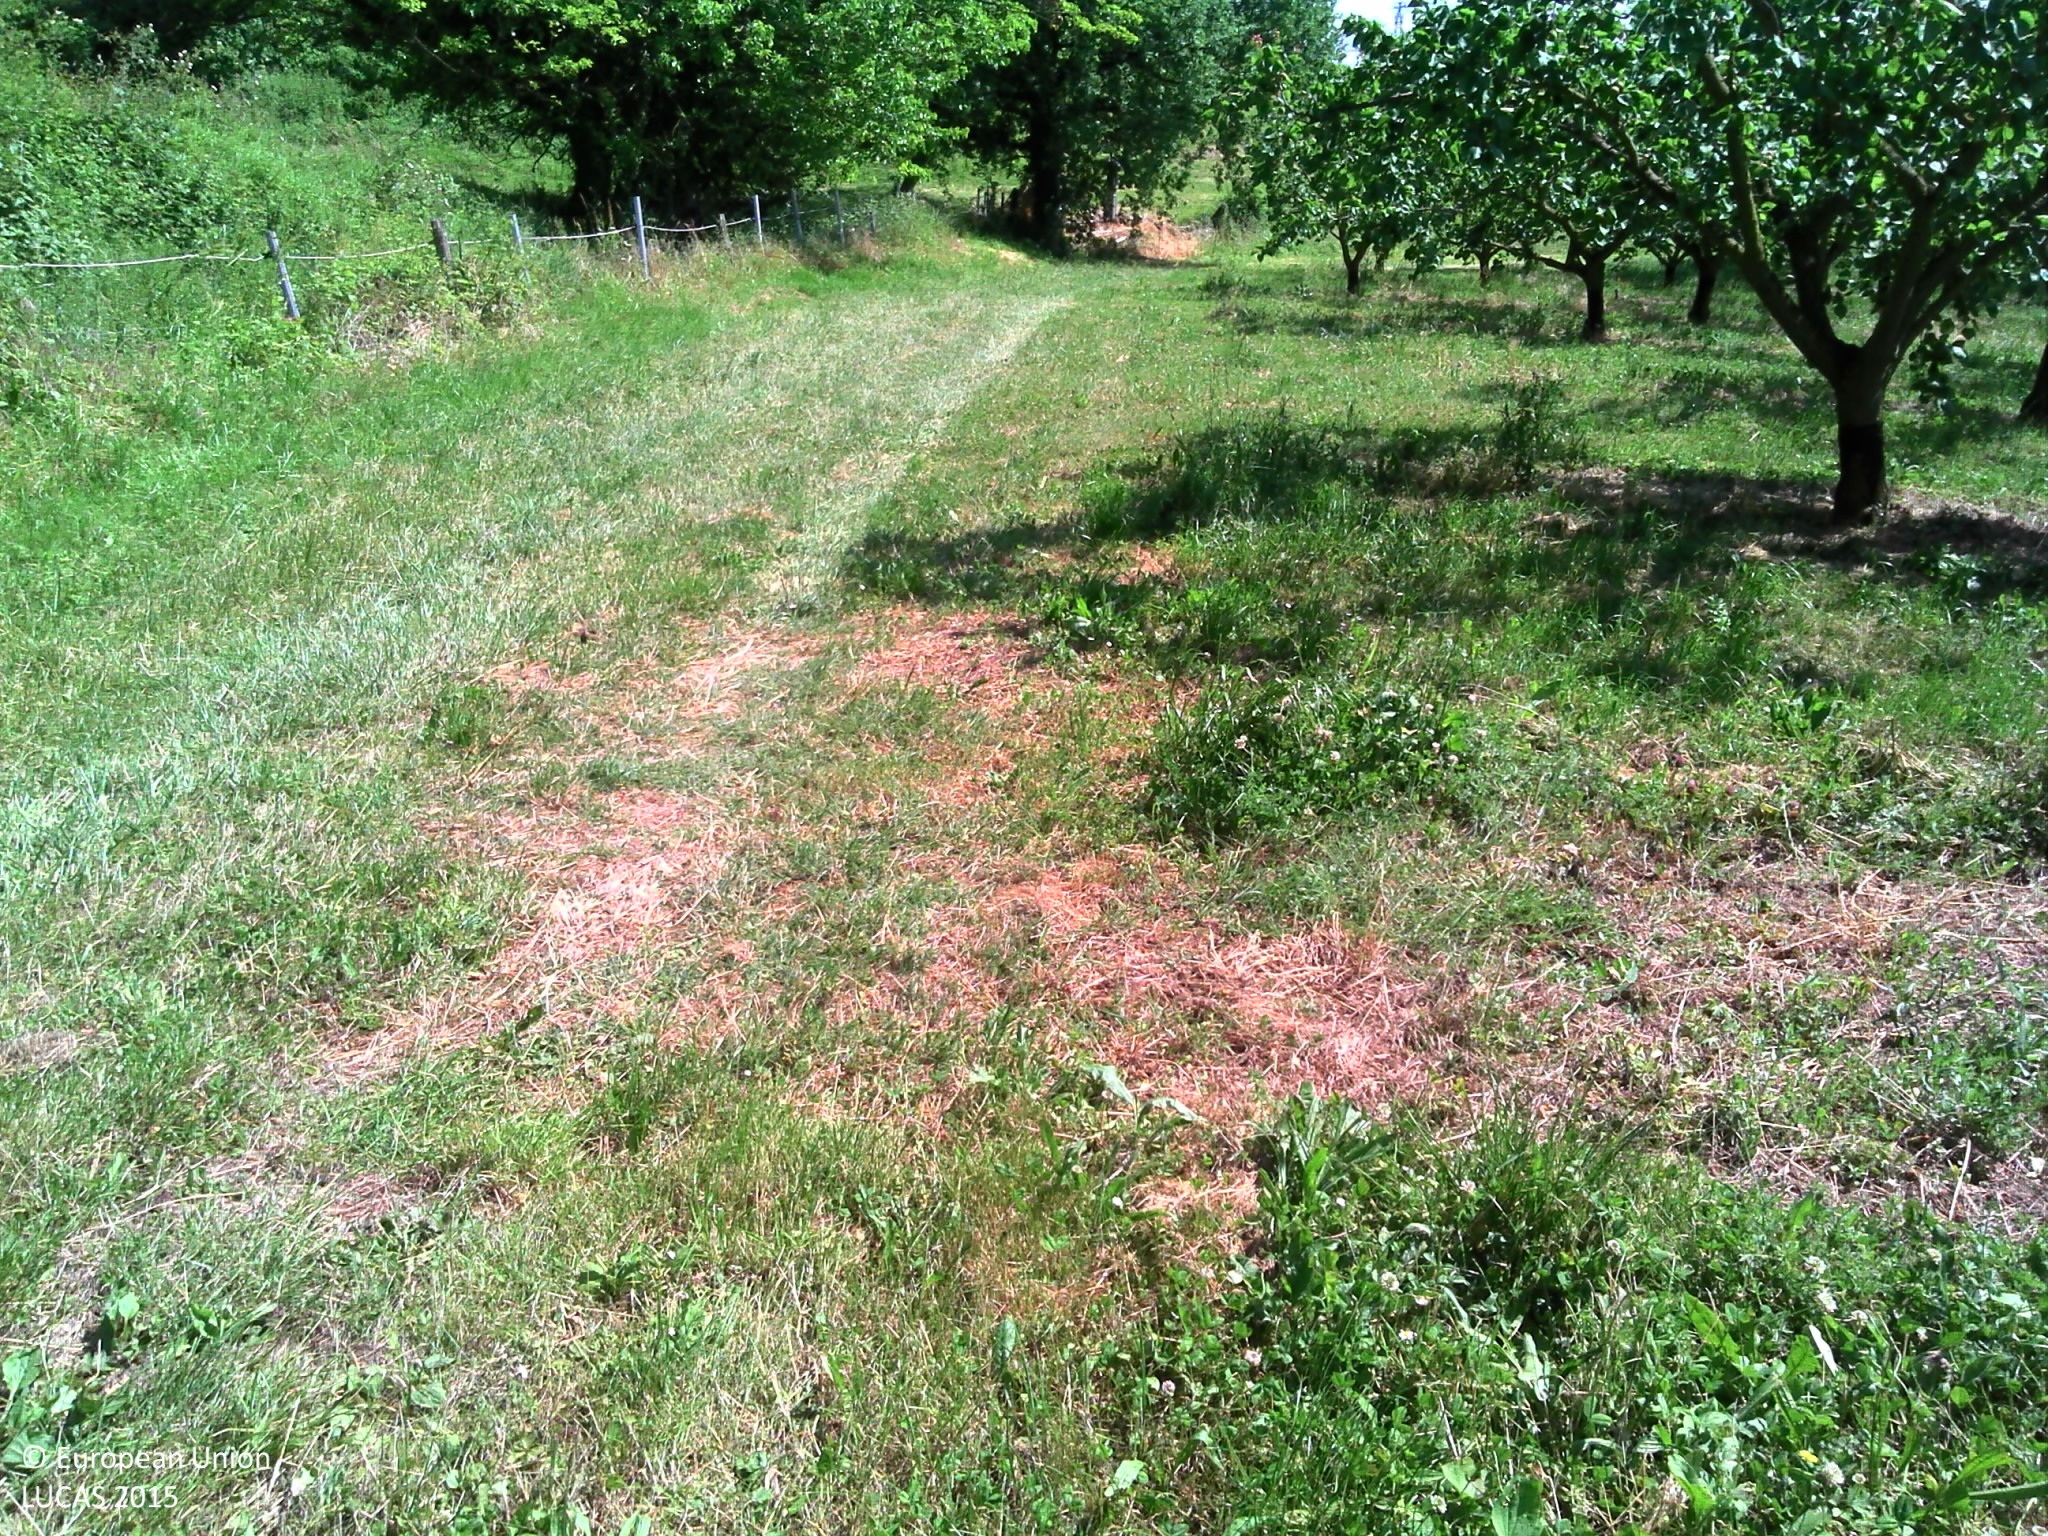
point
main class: Grassland
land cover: Grassland without tree/shrub cover
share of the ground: > 75 %
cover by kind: herbaceous plants 100 %
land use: Agriculture (excluding fallow land and kitchen gardens)
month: May
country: FR
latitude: 45.0748
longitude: 4.9117
